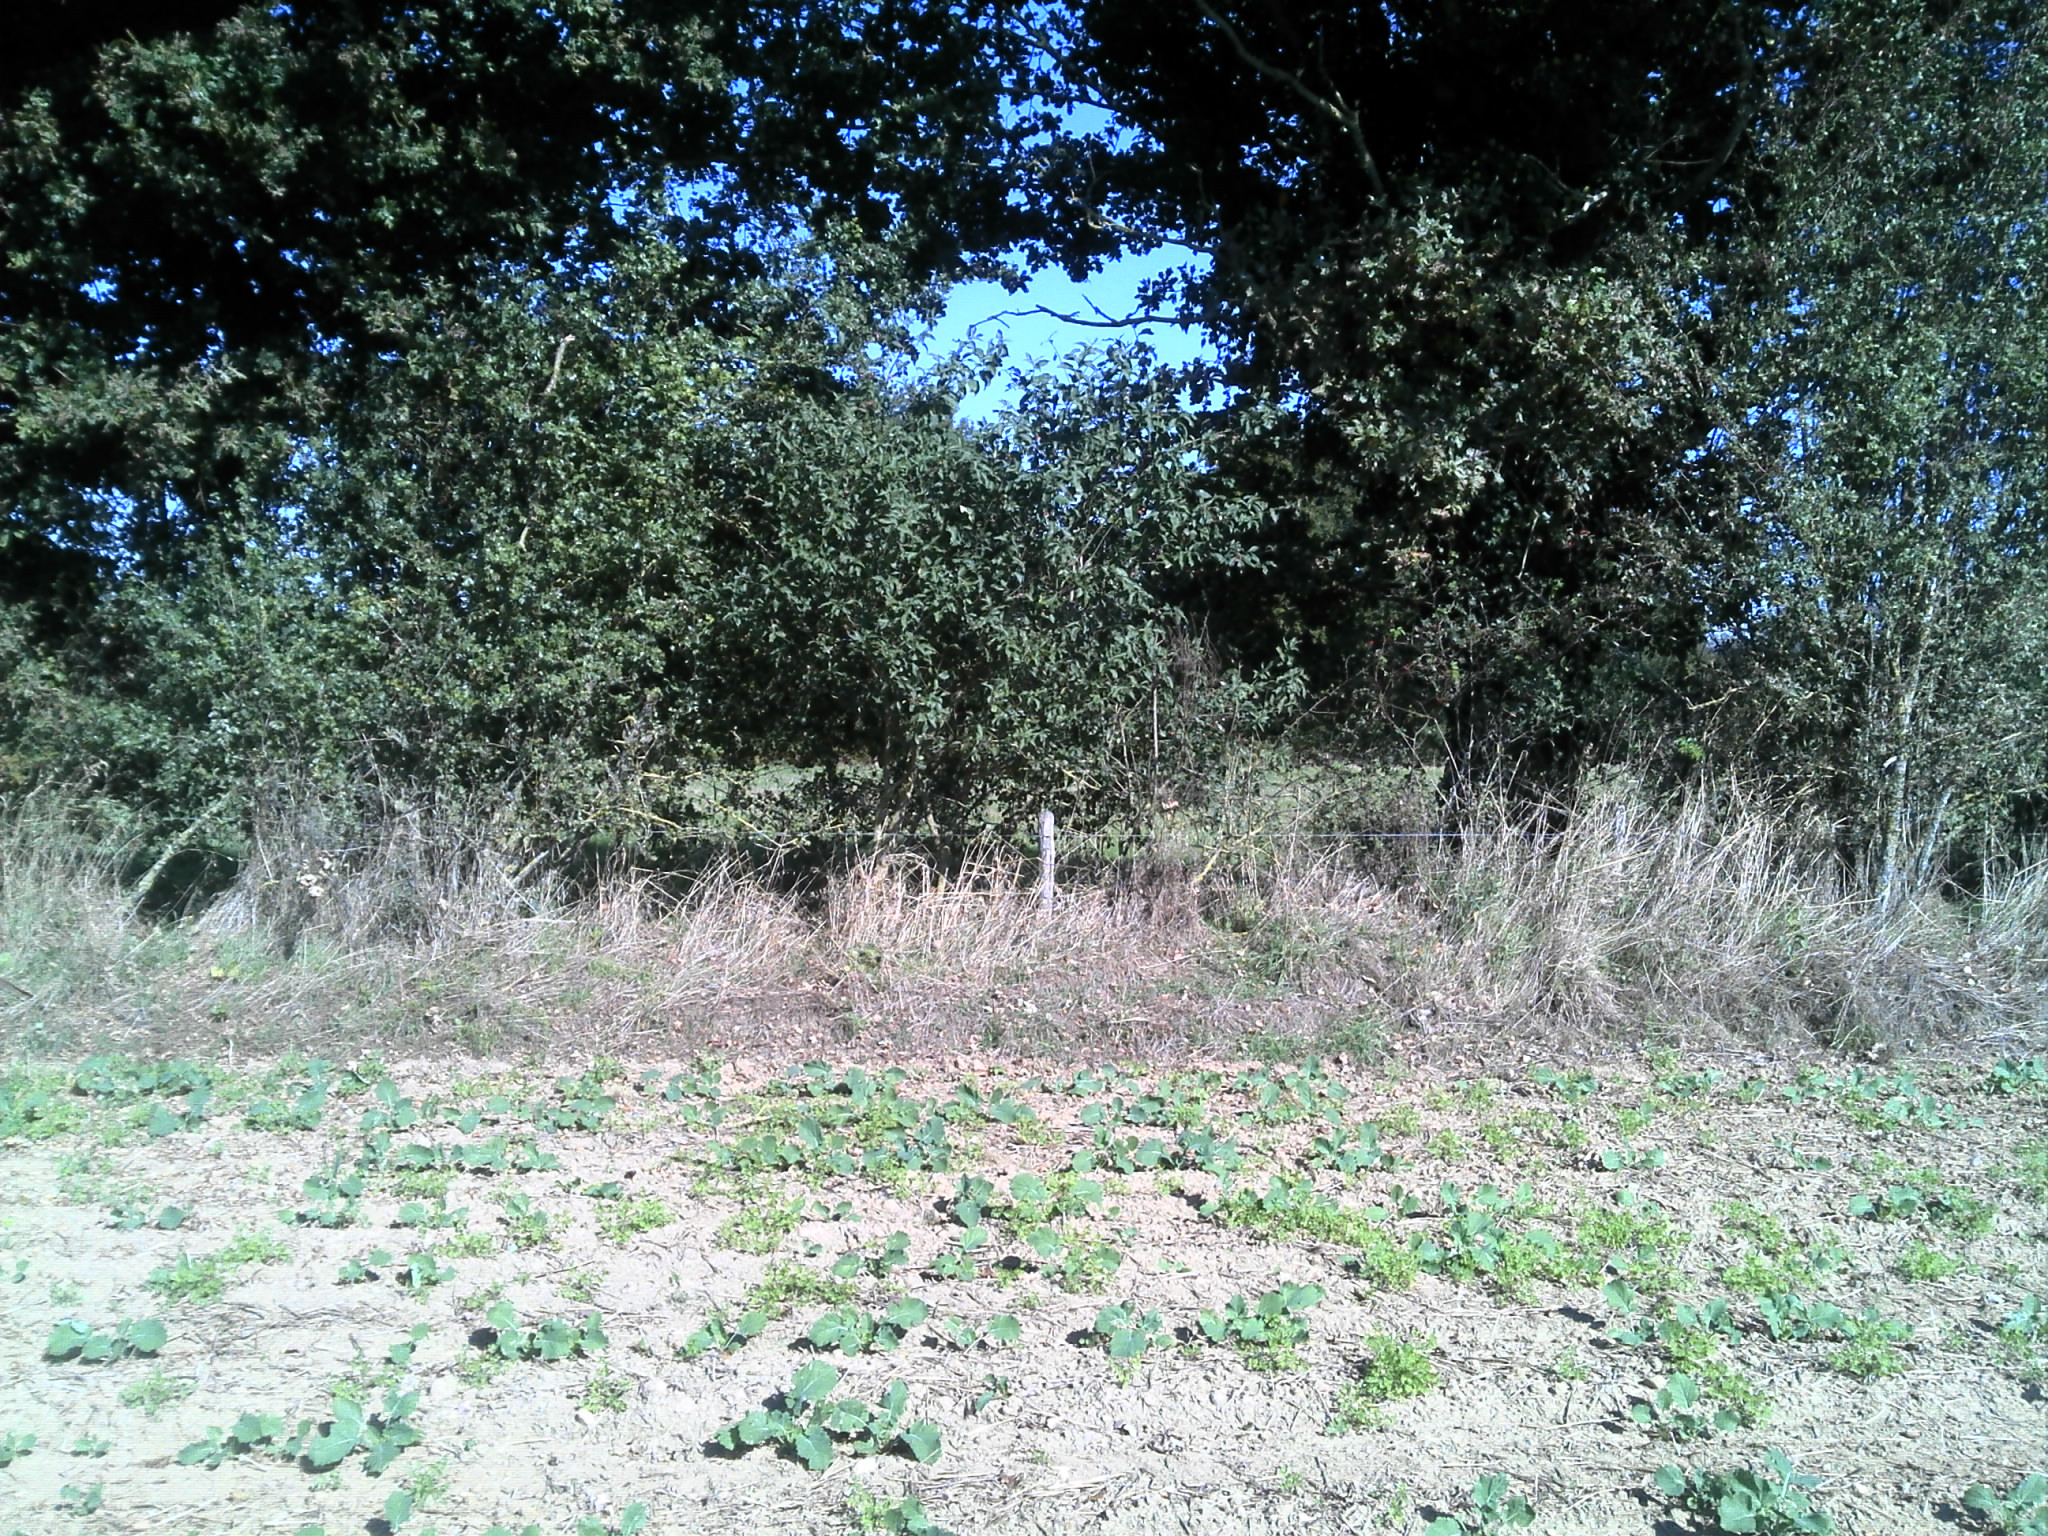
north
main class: Cropland
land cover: Rape and turnip rape
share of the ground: 10 - 25 %
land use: Agriculture (excluding fallow land and kitchen gardens)
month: October
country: FR
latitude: 47.6332
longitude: -1.0172
